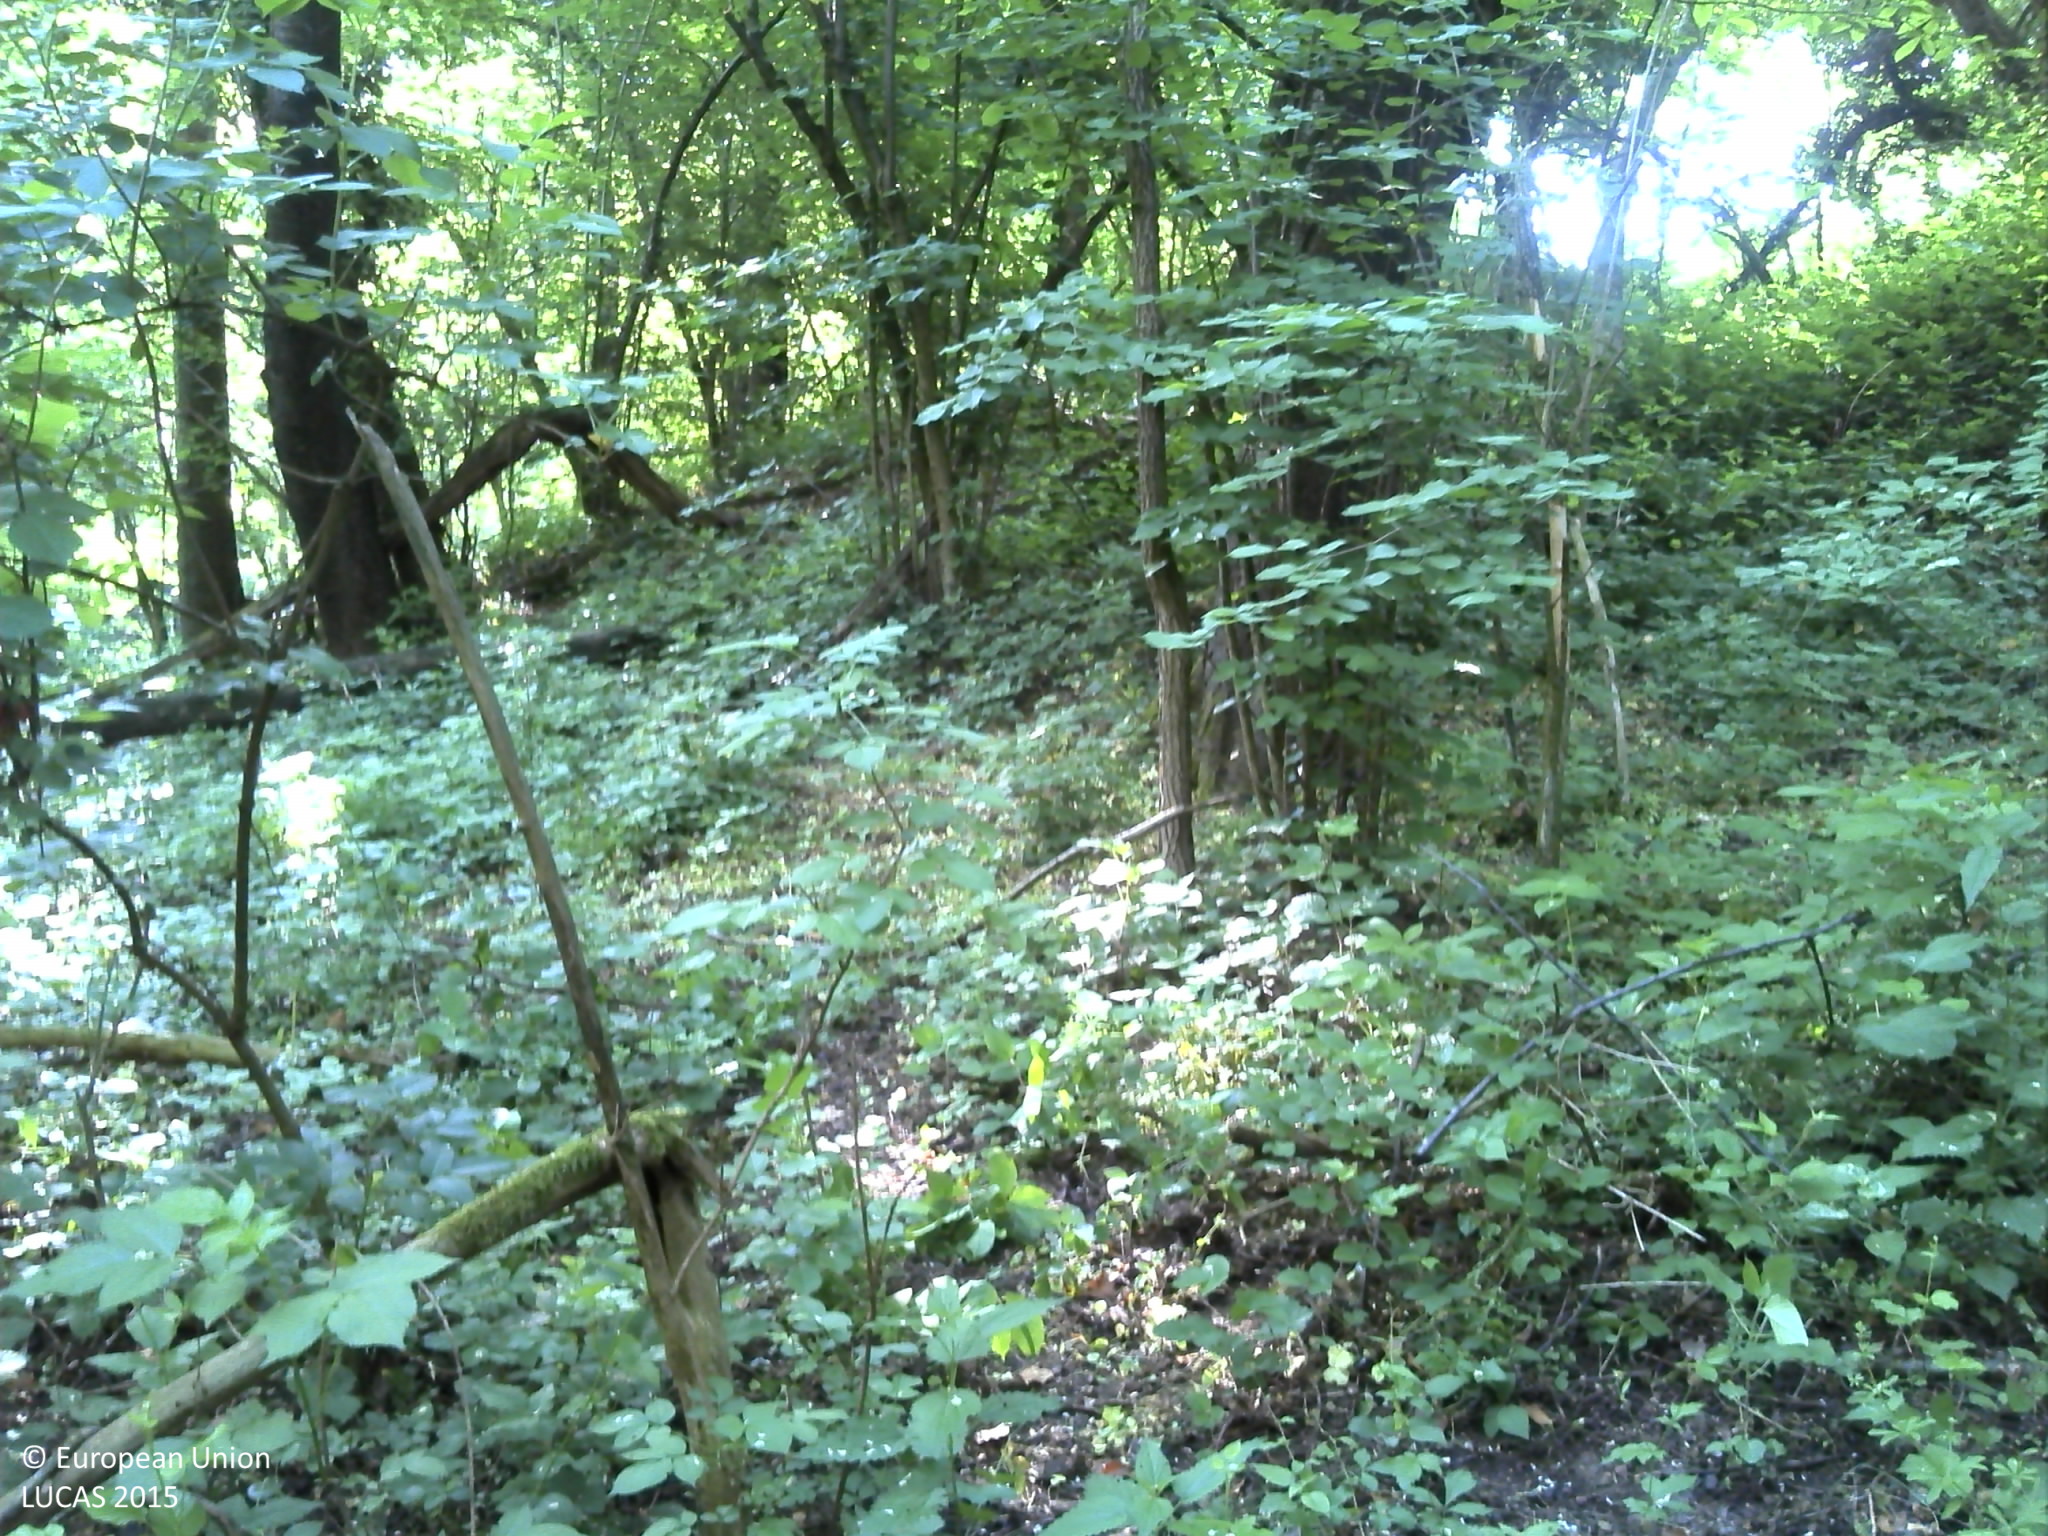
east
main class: Woodland
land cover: Broadleaved woodland
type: mesophytic deciduous forest
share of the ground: > 75 %
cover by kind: broadleaved forest trees 100 %
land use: Forestry
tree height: > 5 m
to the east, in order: Broadleaved woodland
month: May
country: HR
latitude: 45.4939
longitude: 17.9500
